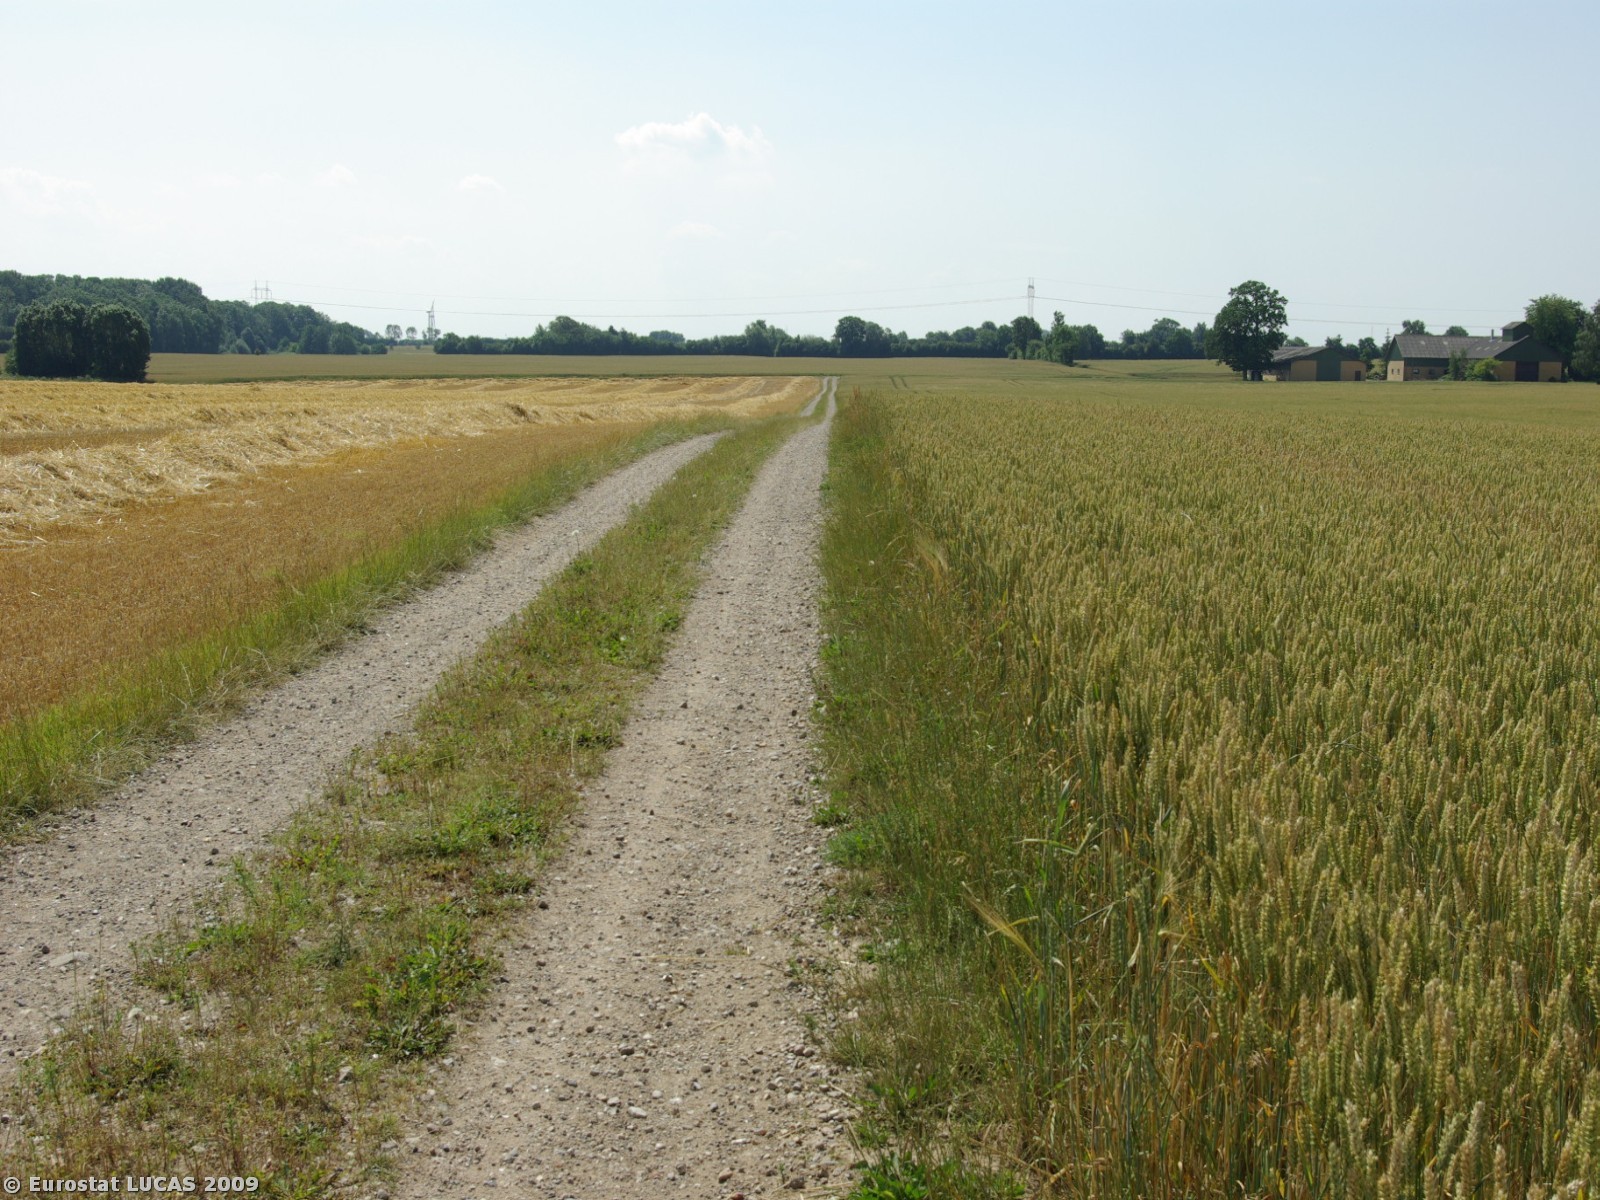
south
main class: Cropland
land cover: Common wheat
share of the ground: > 75 %
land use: Agriculture (excluding fallow land and kitchen gardens)
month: July
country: DK
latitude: 54.9651
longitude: 9.6723
